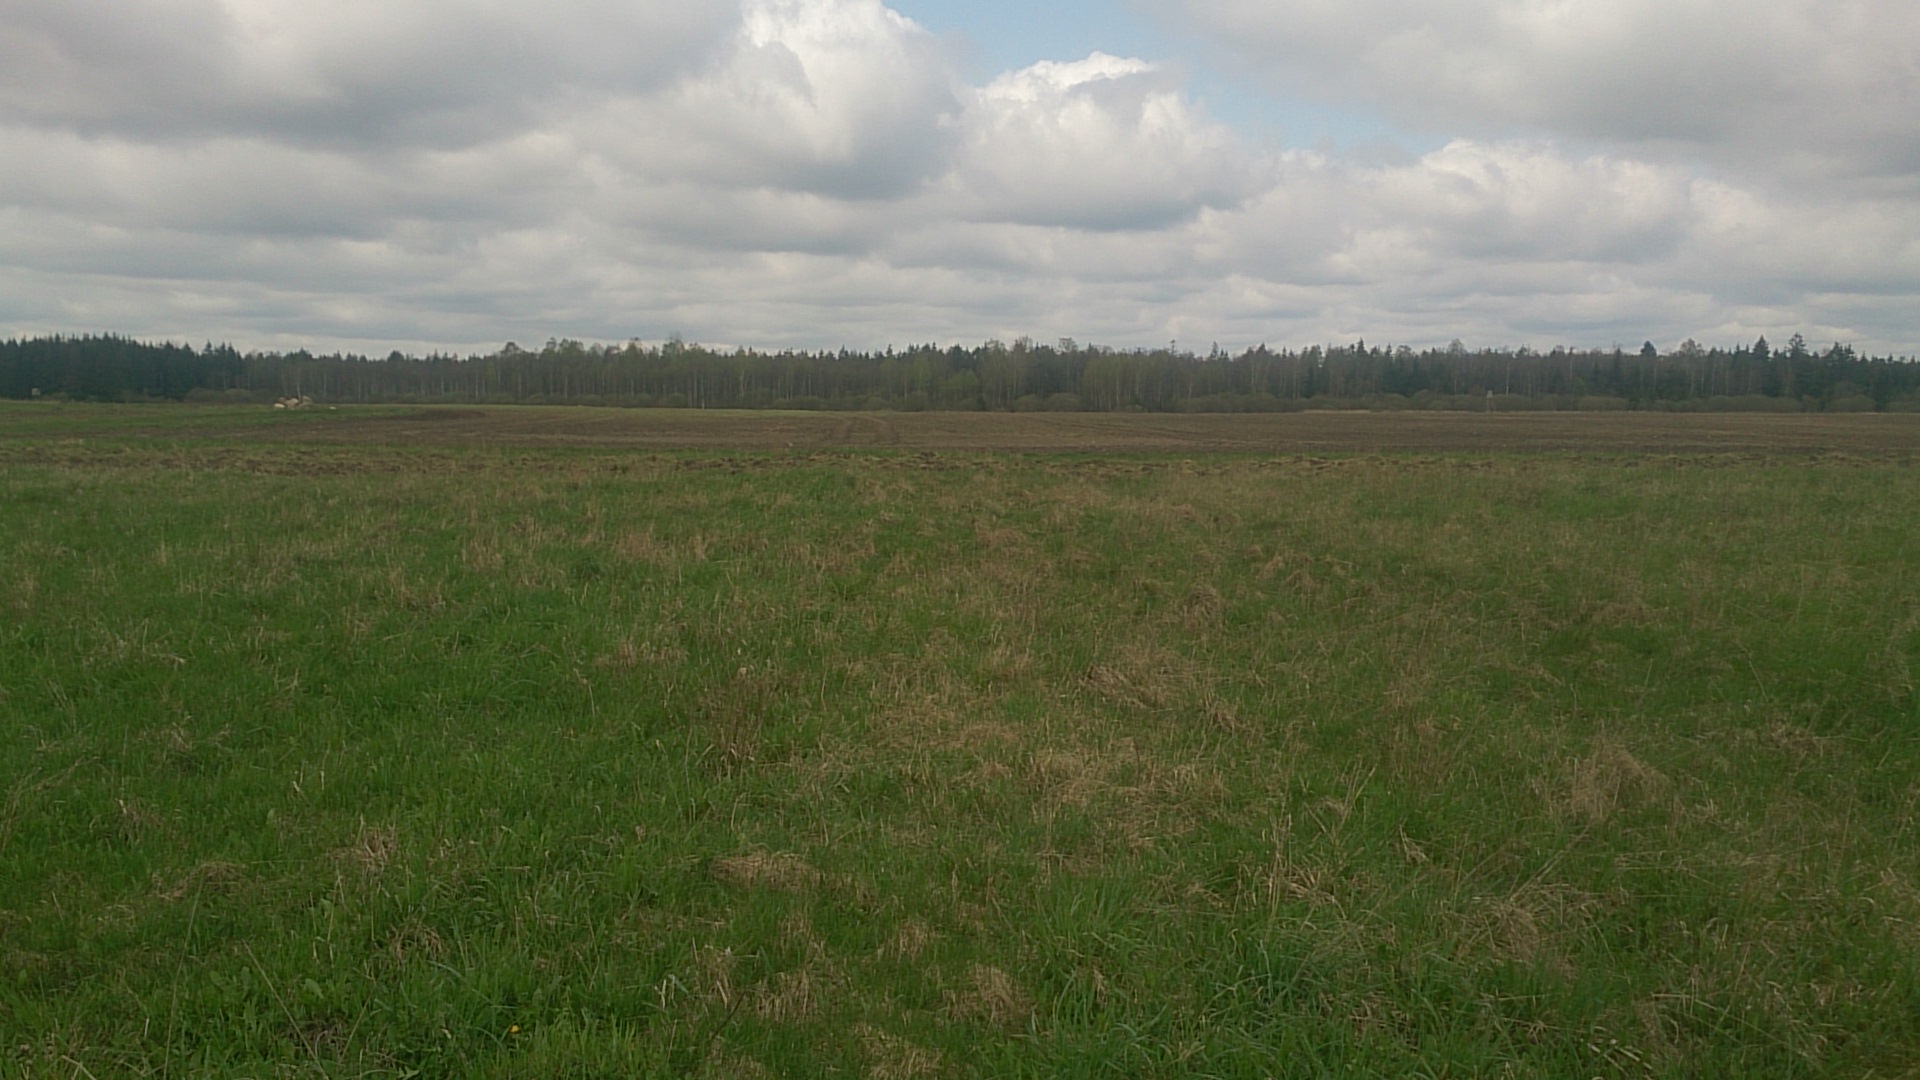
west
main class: Grassland
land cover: Grassland without tree/shrub cover
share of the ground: > 75 %
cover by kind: herbaceous plants 100 %
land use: Agriculture (excluding fallow land and kitchen gardens)
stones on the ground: < 10 %
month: May
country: LT
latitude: 56.3672
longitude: 22.0136
